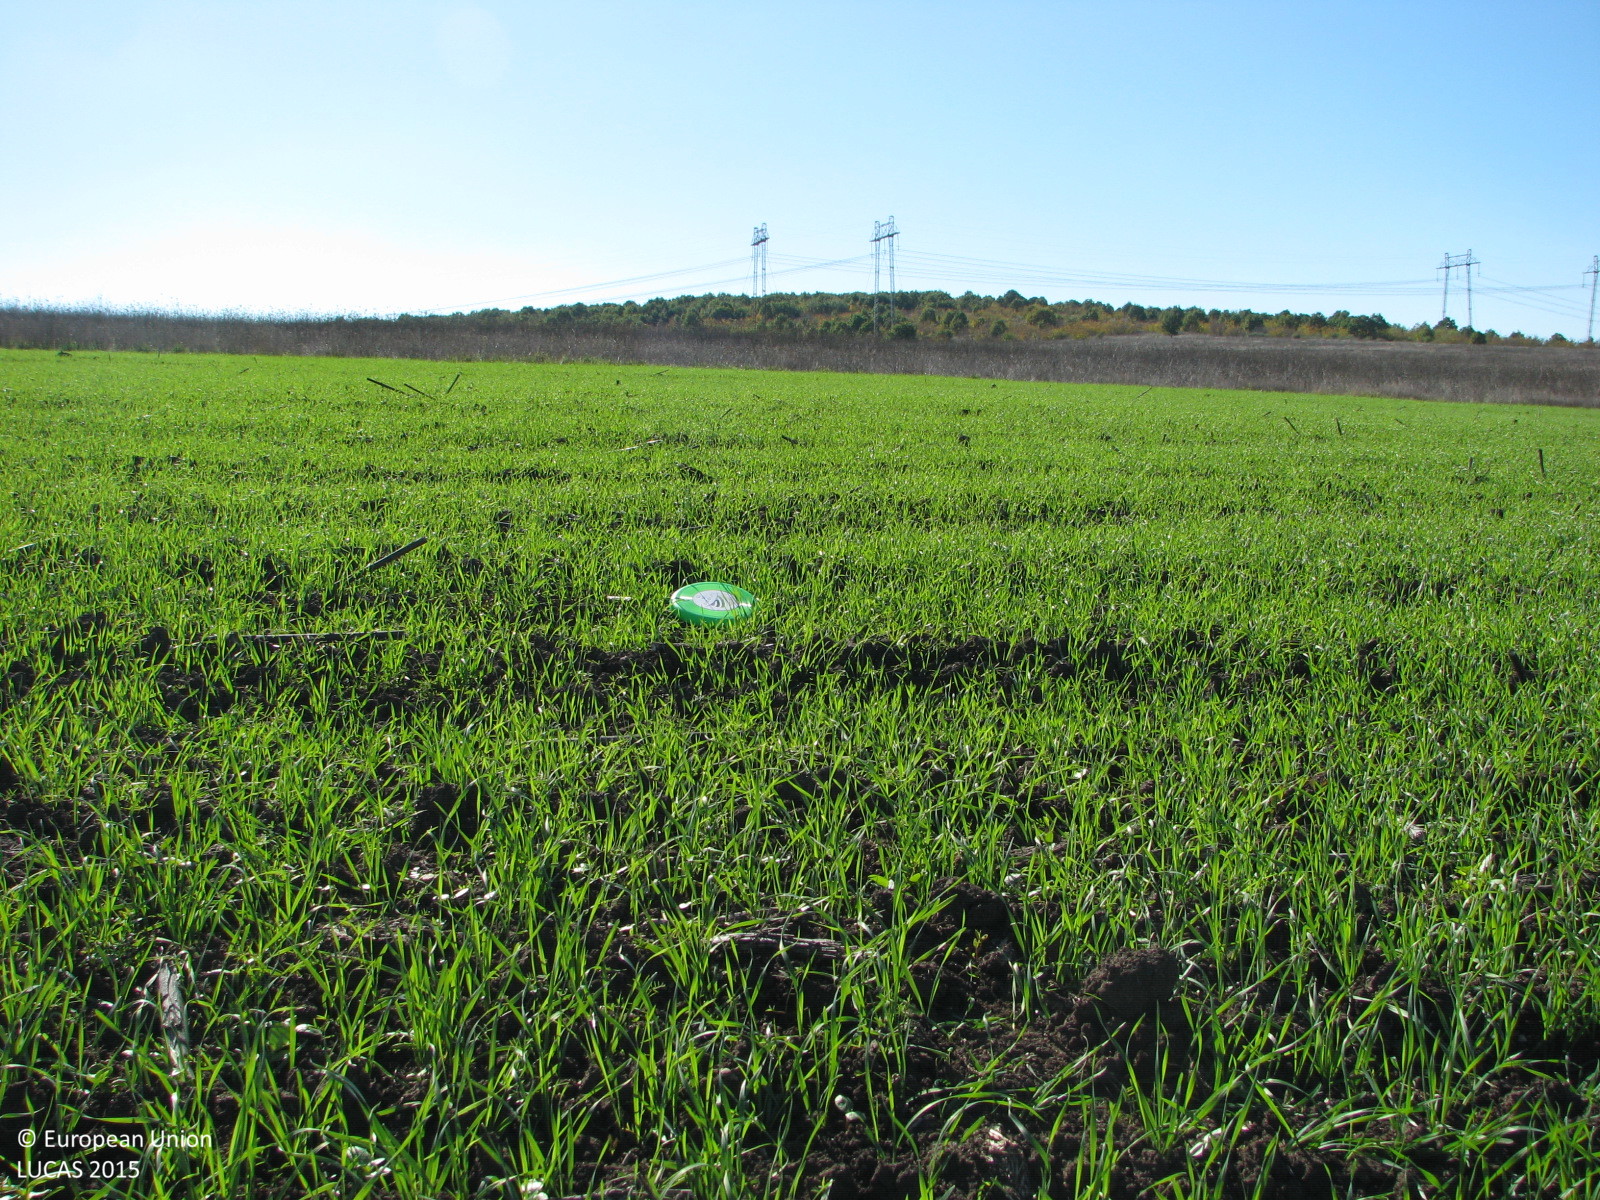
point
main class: Cropland
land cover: Common wheat
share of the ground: 50 - 75 %
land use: Agriculture (excluding fallow land and kitchen gardens)
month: October
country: BG
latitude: 42.1781
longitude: 26.2445
